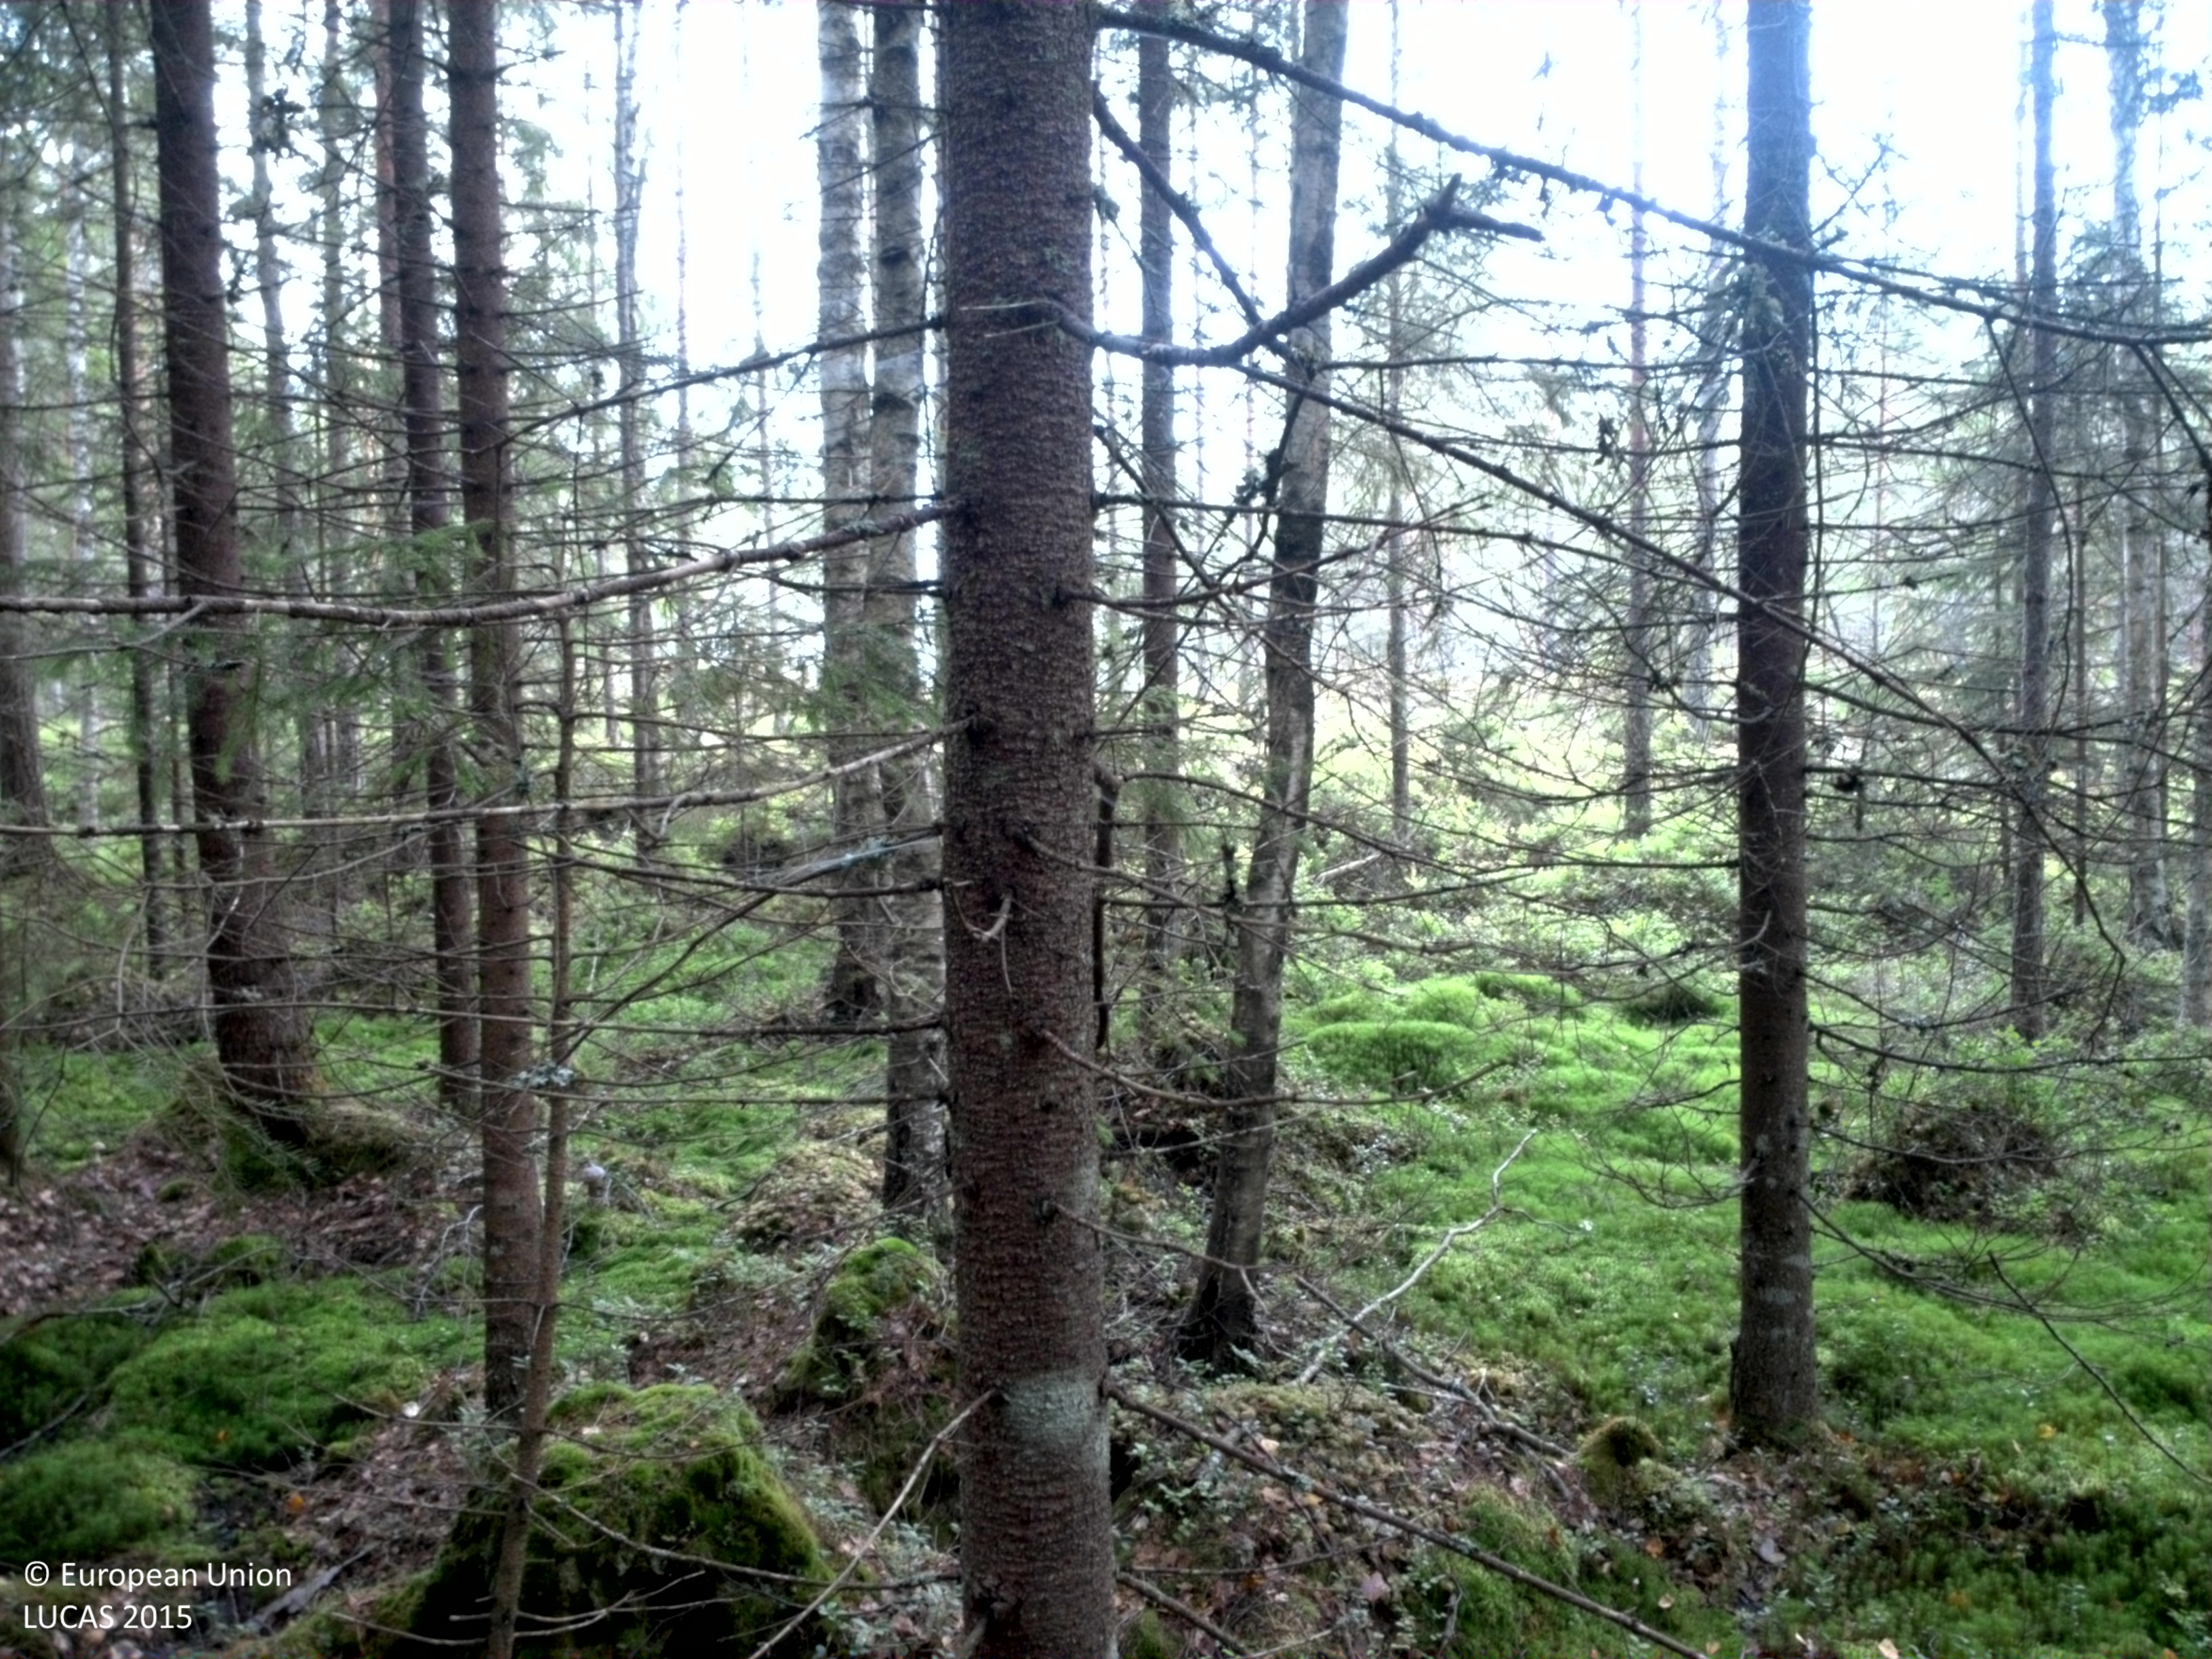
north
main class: Woodland
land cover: Spruce dominated coniferous woodland
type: boreal forest
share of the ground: 50 - 75 %
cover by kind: coniferous forest trees 65 %, lichens and mosses 20 %, shrubs 10 %, broadleaved forest trees 5 %
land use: Forestry
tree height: > 5 m
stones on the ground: < 10 %
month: August
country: SE
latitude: 59.2501
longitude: 11.8715
